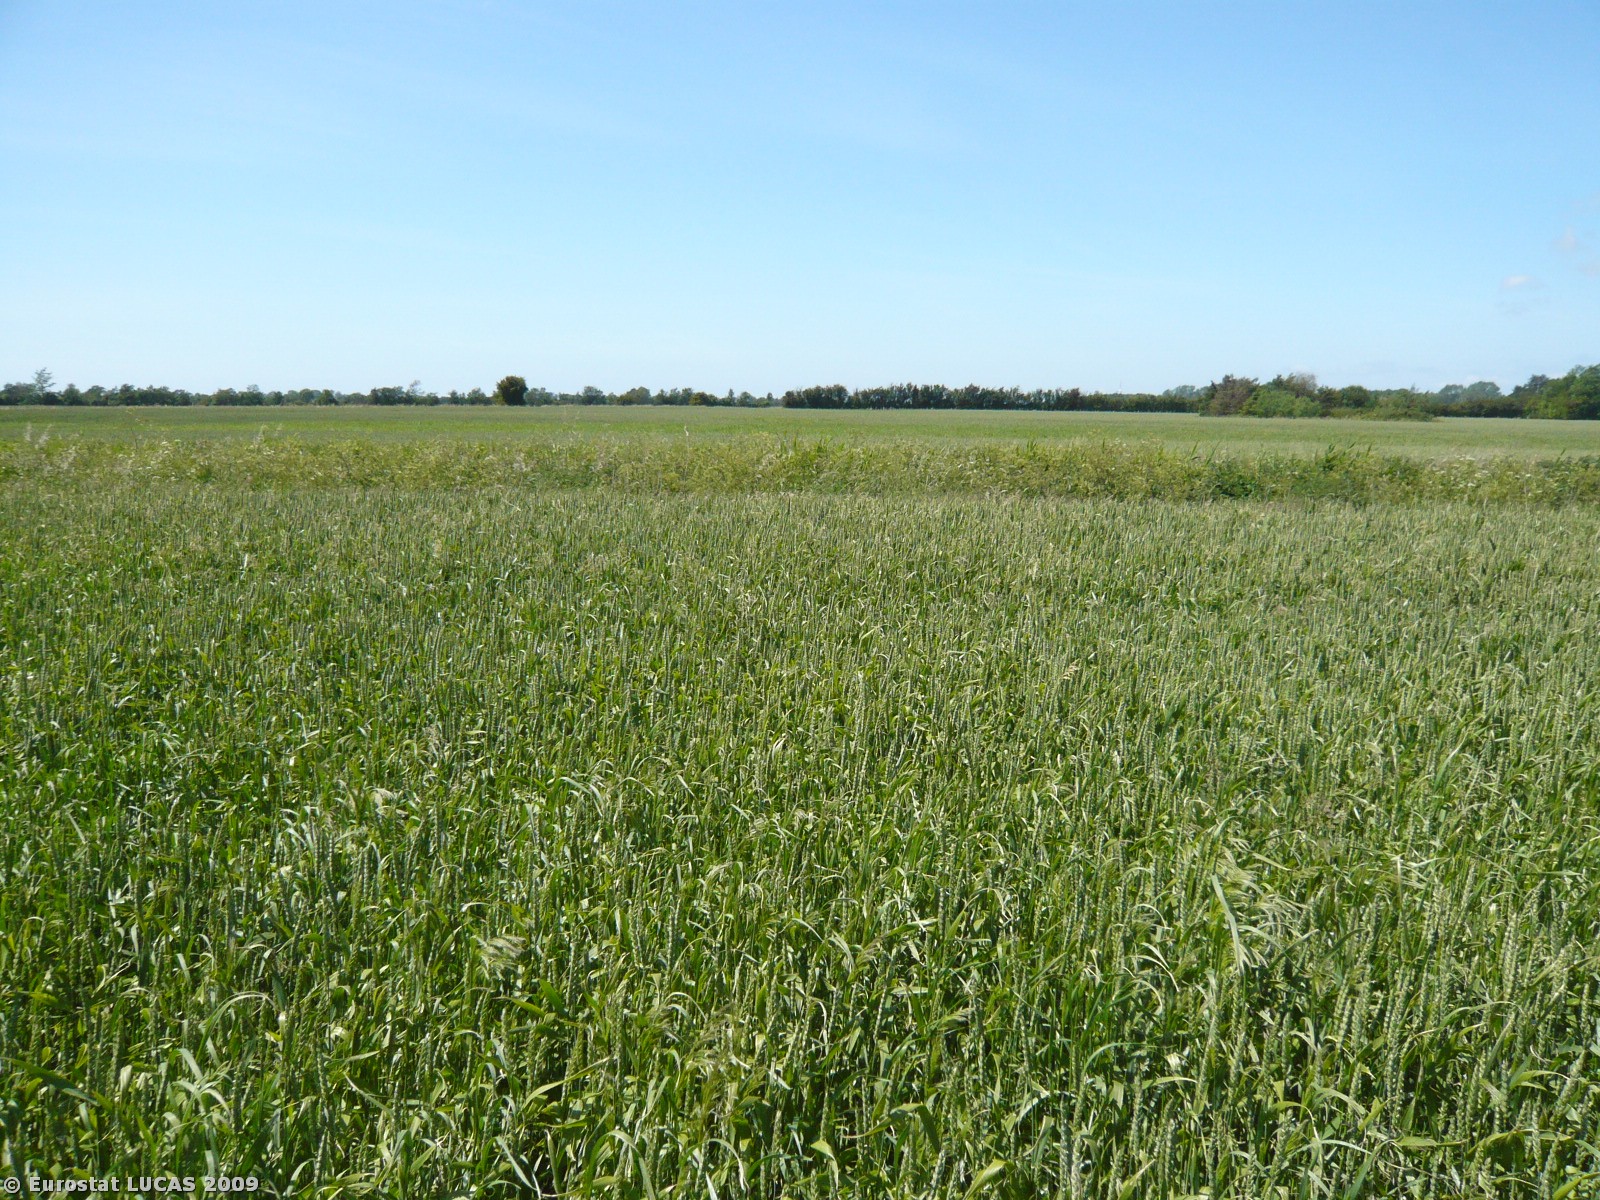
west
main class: Cropland
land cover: Common wheat
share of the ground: > 75 %
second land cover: Barley
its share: 10 - 25 %
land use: Agriculture (excluding fallow land and kitchen gardens)
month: June
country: DK
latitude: 54.7252
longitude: 11.2879
